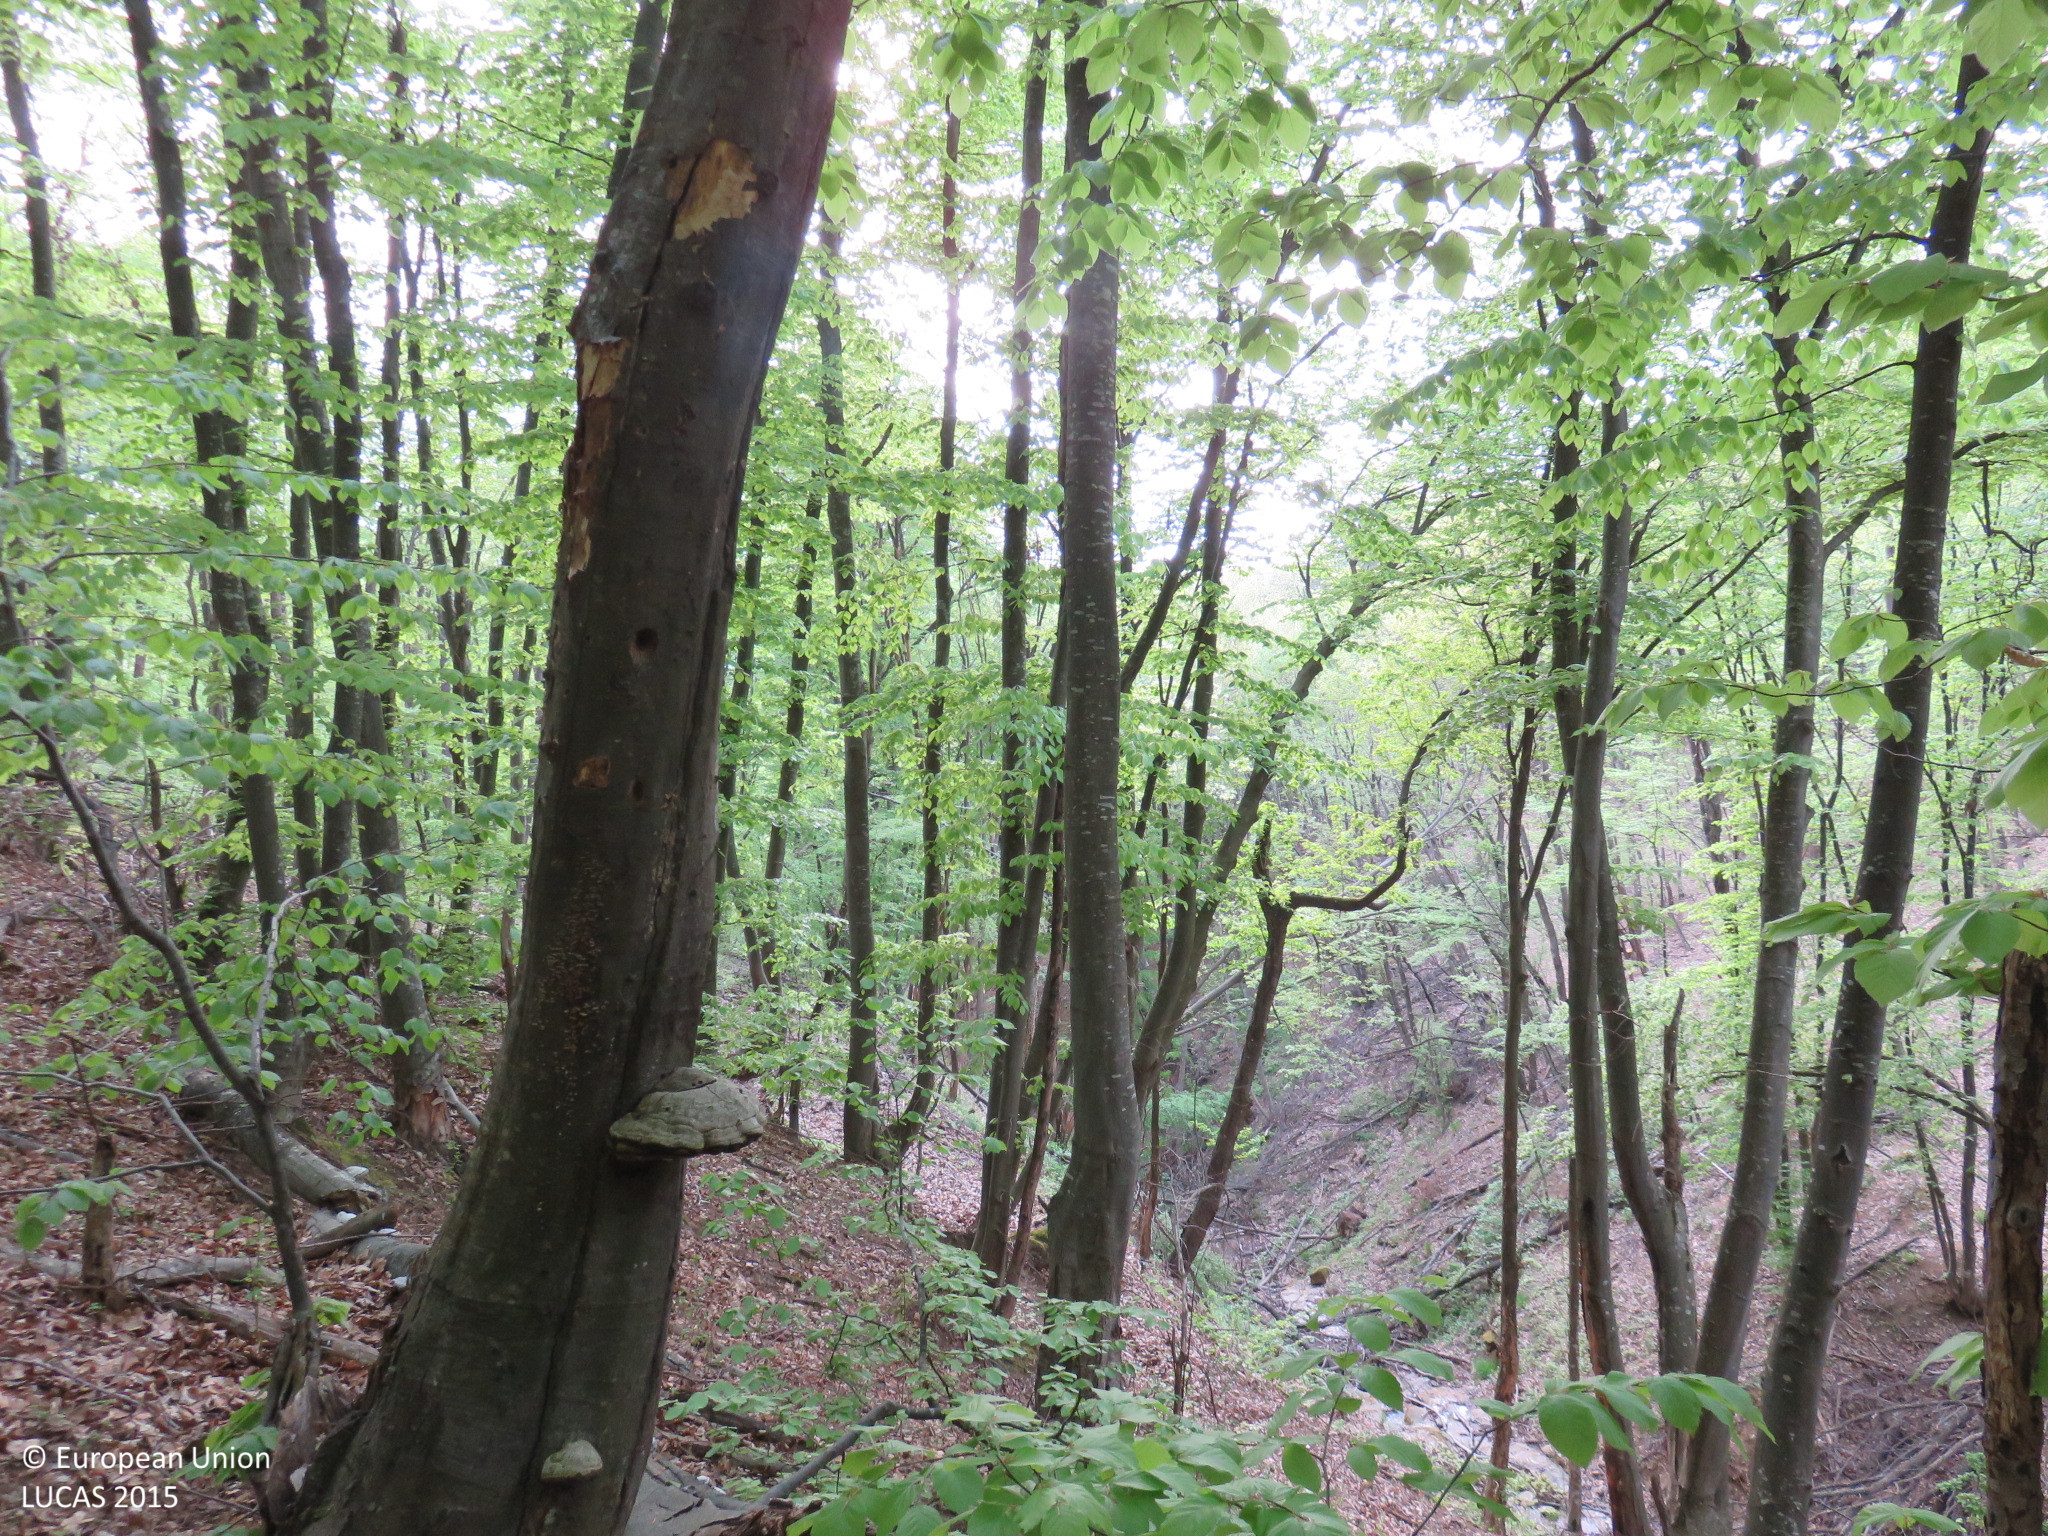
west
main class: Woodland
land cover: Broadleaved woodland
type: beech forest
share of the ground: > 75 %
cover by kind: broadleaved forest trees 80 %, unconsolidated bare surface 20 %
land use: Forestry
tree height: > 5 m
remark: Clear cut
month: April
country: BG
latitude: 43.0187
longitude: 24.8490
